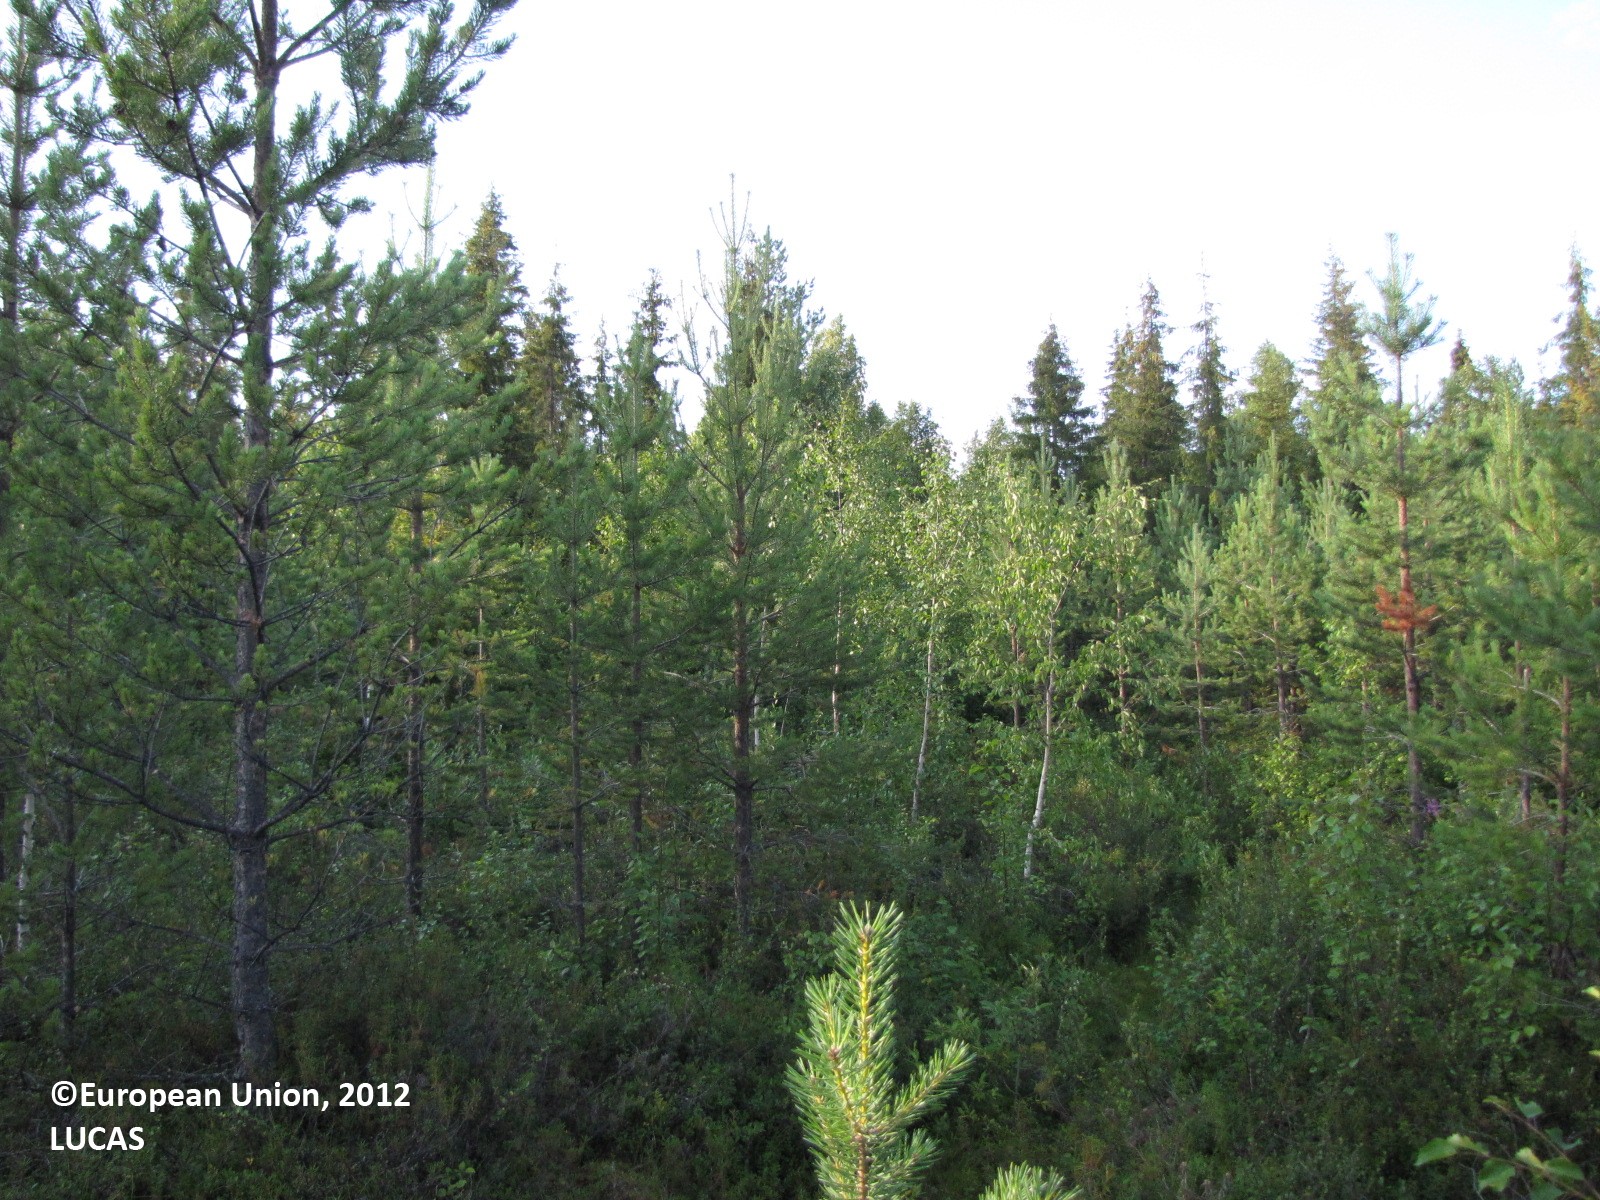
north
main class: Woodland
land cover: Pine dominated coniferous woodland
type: boreal forest
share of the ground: 50 - 75 %
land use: Forestry
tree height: < 5 m
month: July
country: FI
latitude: 66.7013
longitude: 24.4740
